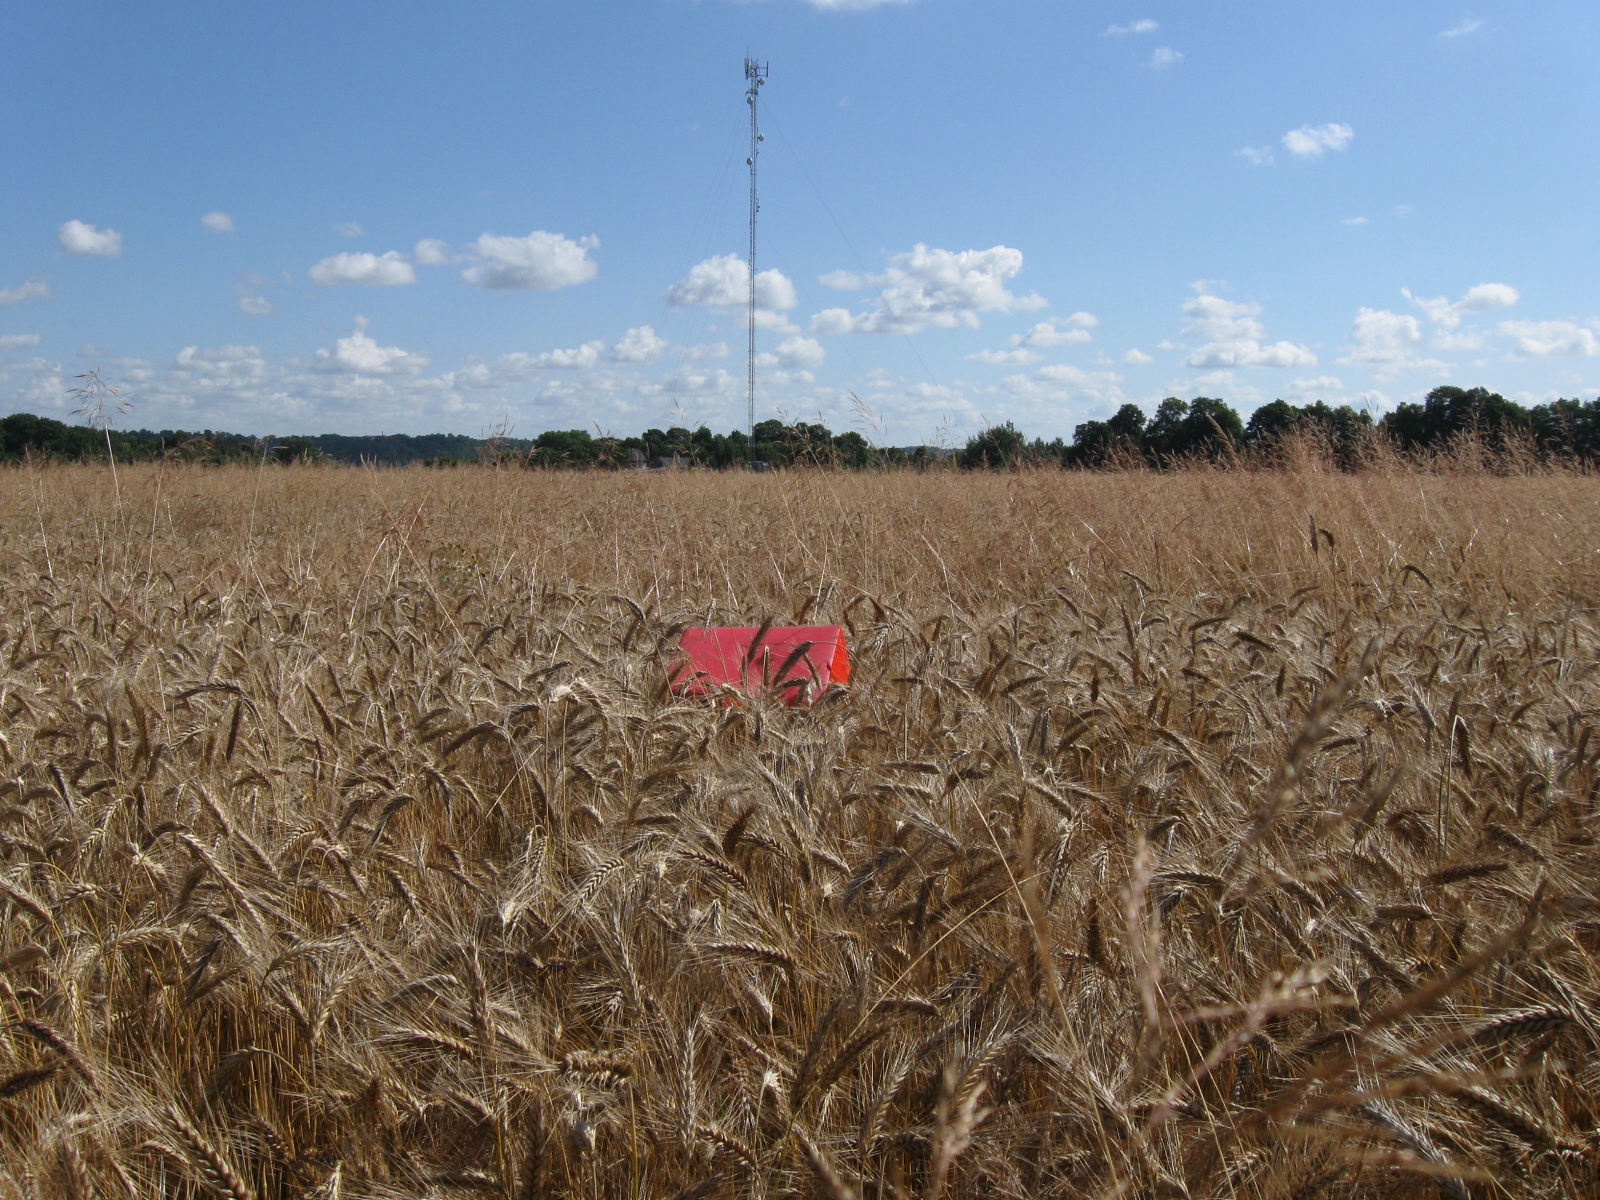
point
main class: Cropland
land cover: Durum wheat
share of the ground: > 75 %
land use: Agriculture (excluding fallow land and kitchen gardens)
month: July
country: LT
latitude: 55.0296
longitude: 23.5196
